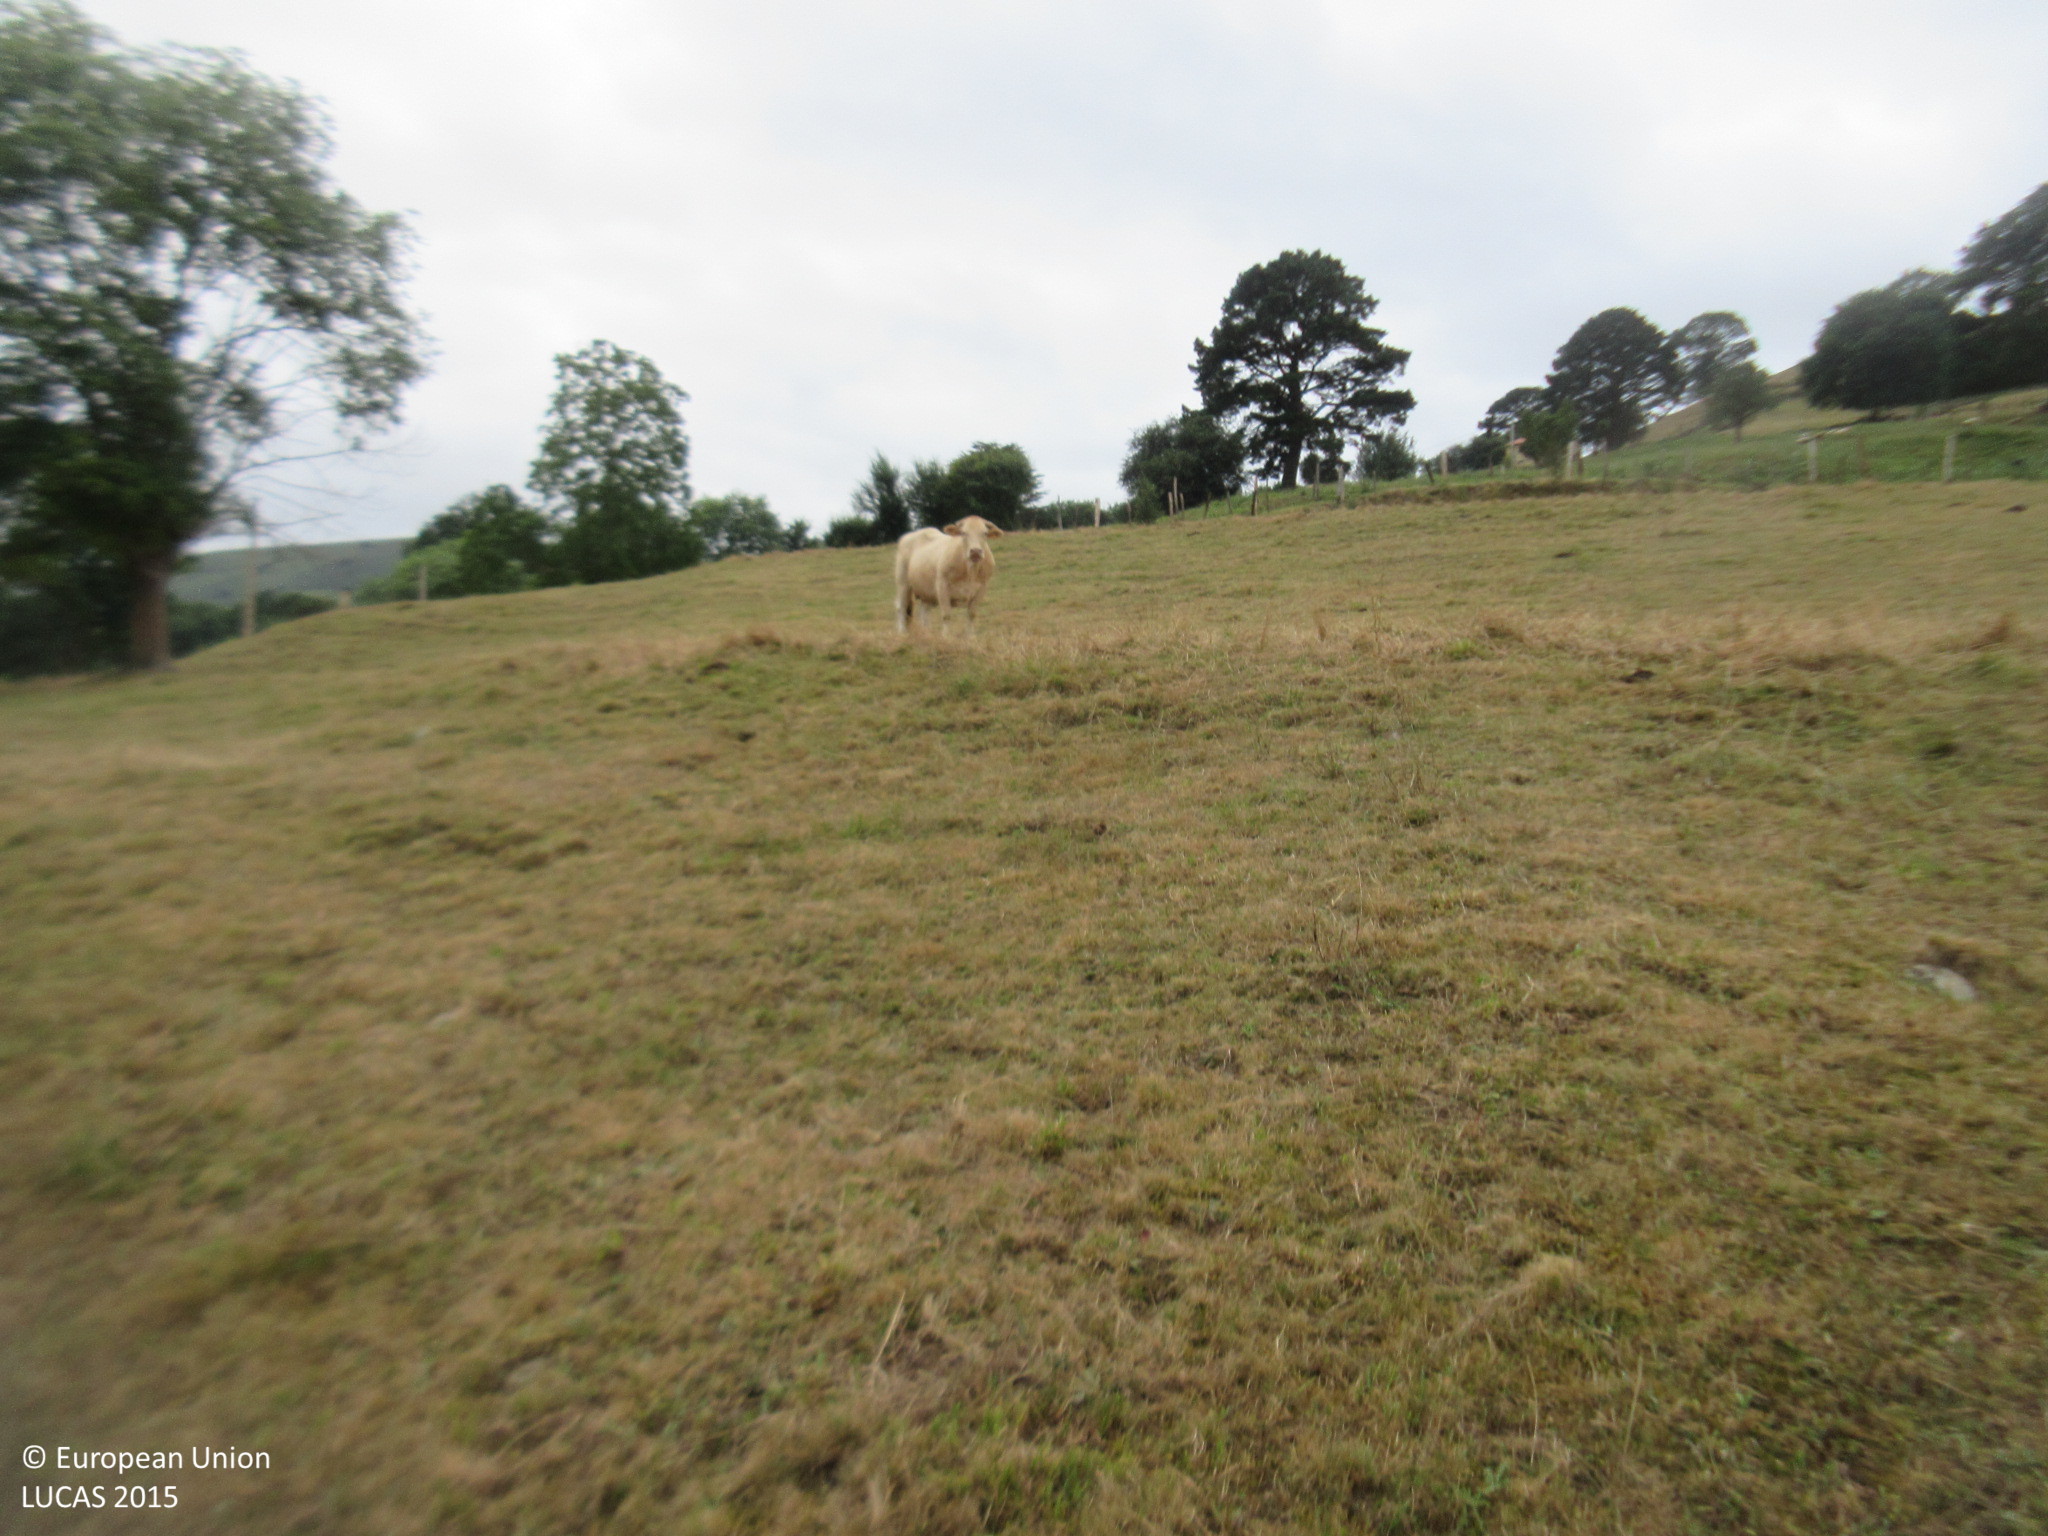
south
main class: Grassland
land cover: Grassland without tree/shrub cover
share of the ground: > 75 %
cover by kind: herbaceous plants 100 %
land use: Agriculture (excluding fallow land and kitchen gardens)
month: July
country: ES
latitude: 43.2026
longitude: -3.9438
